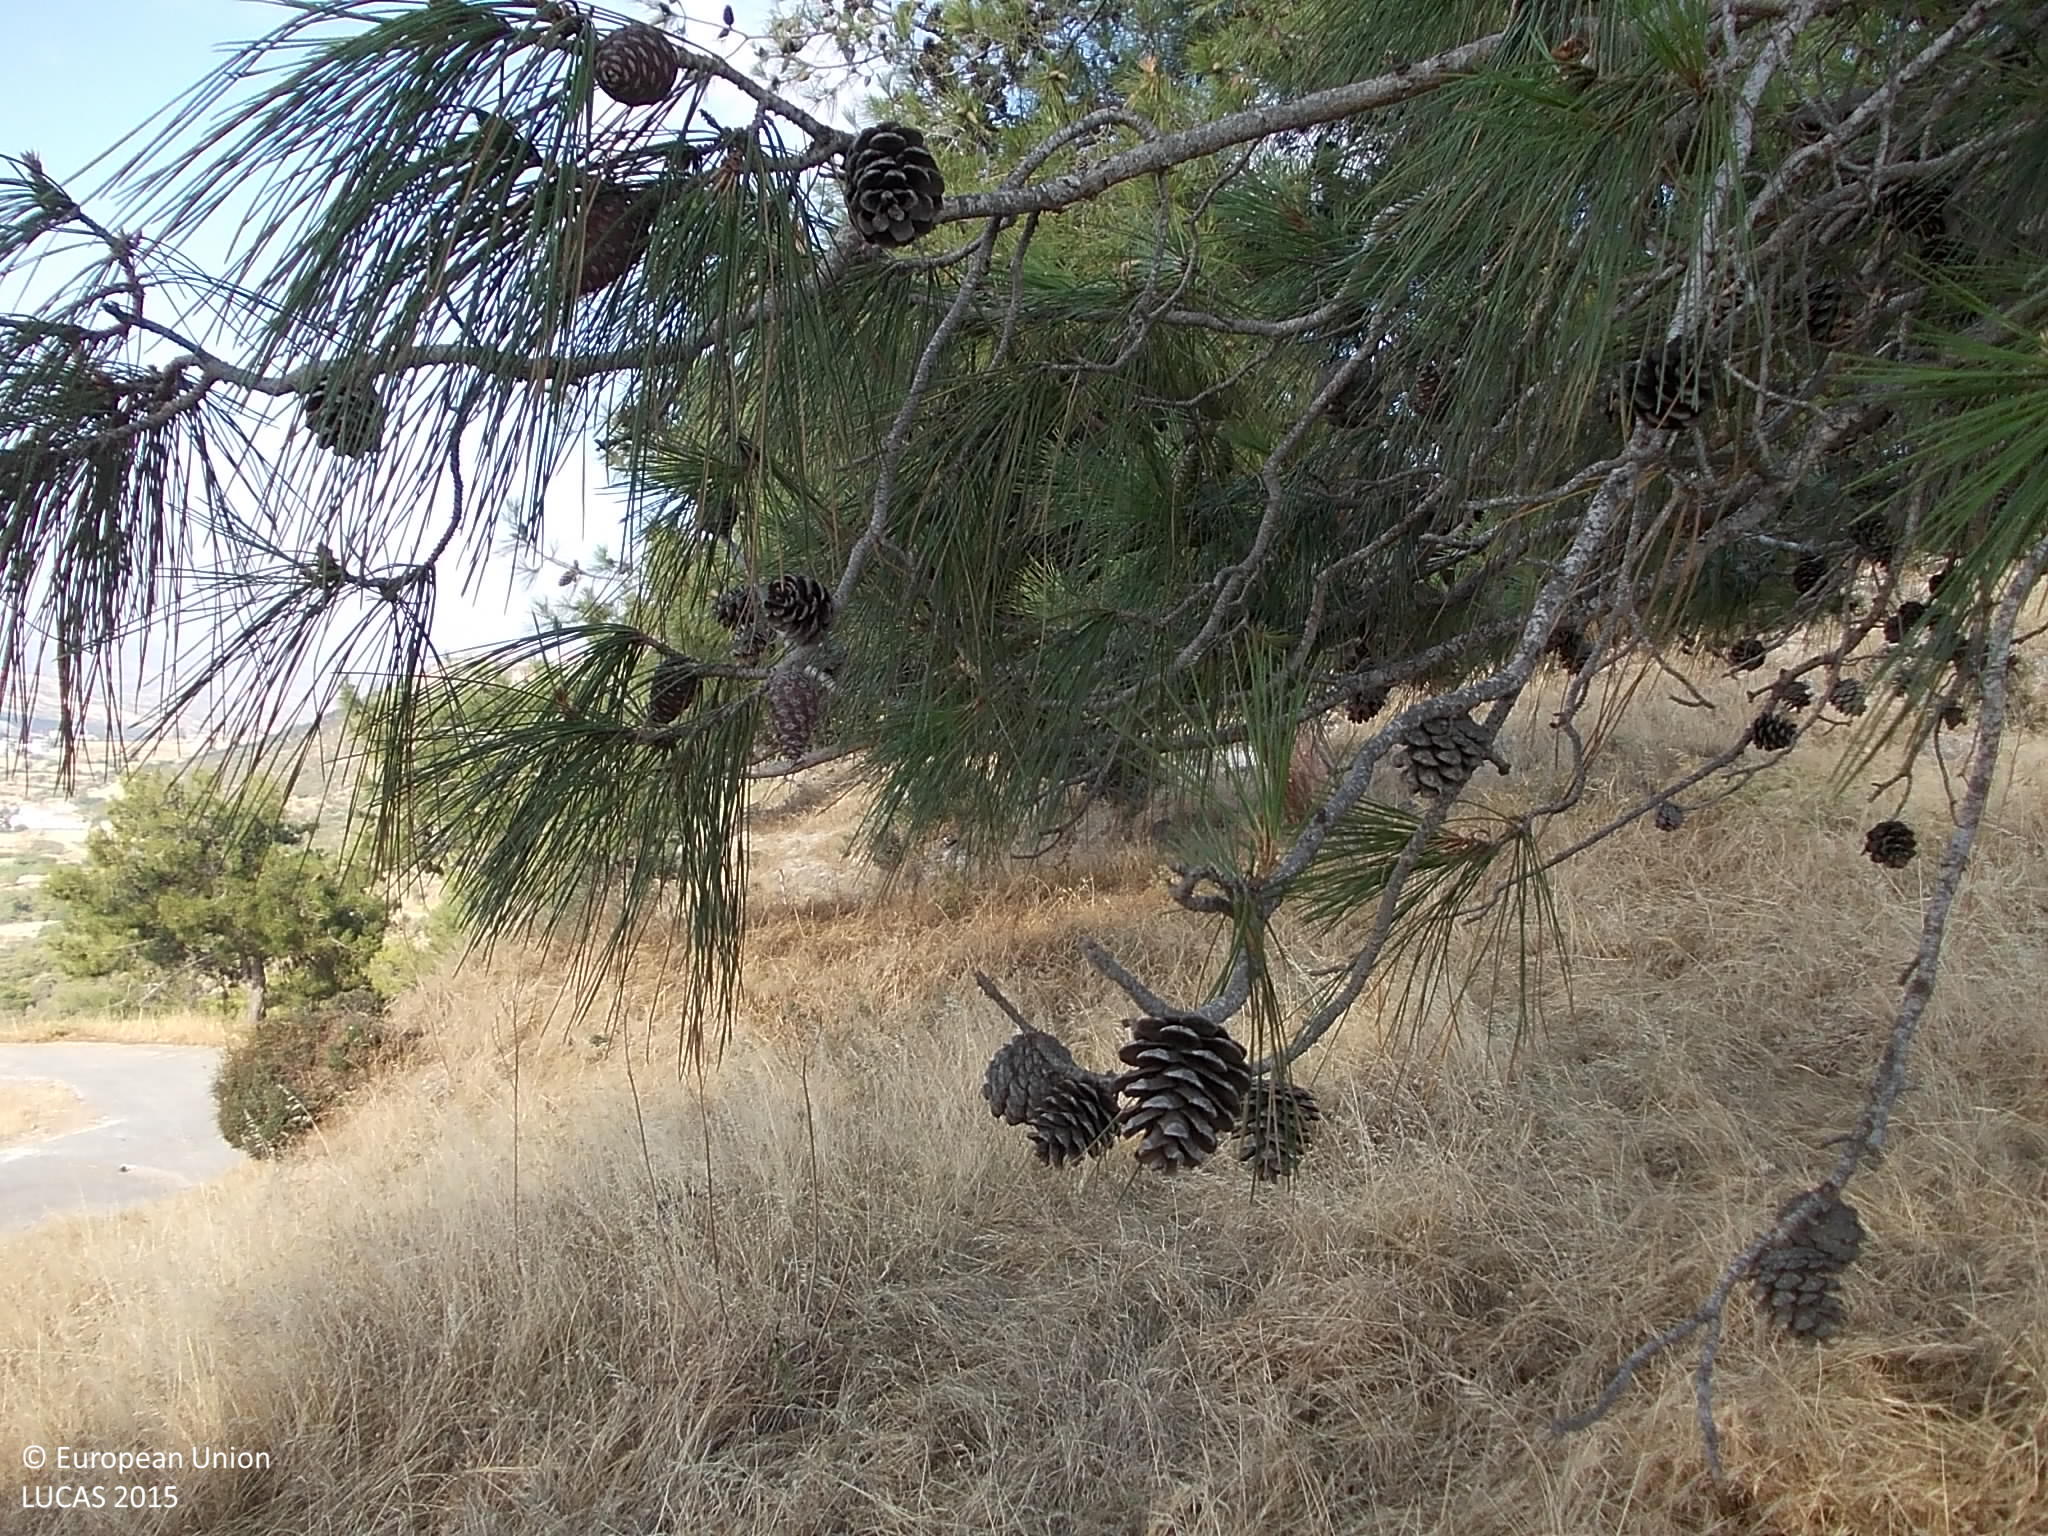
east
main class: Woodland
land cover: Pine dominated coniferous woodland
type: coniferous forest of the mediterranean region
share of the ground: 25 - 50 %
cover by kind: herbaceous plants 50 %, coniferous forest trees 35 %, consolidated bare surface 15 %
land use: Semi-natural and natural areas not in use
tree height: > 5 m
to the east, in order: Pine dominated coniferous woodland; Grassland without tree/shrub cover; Pine dominated coniferous woodland
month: June
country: CY
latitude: 34.6676
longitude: 32.6857
